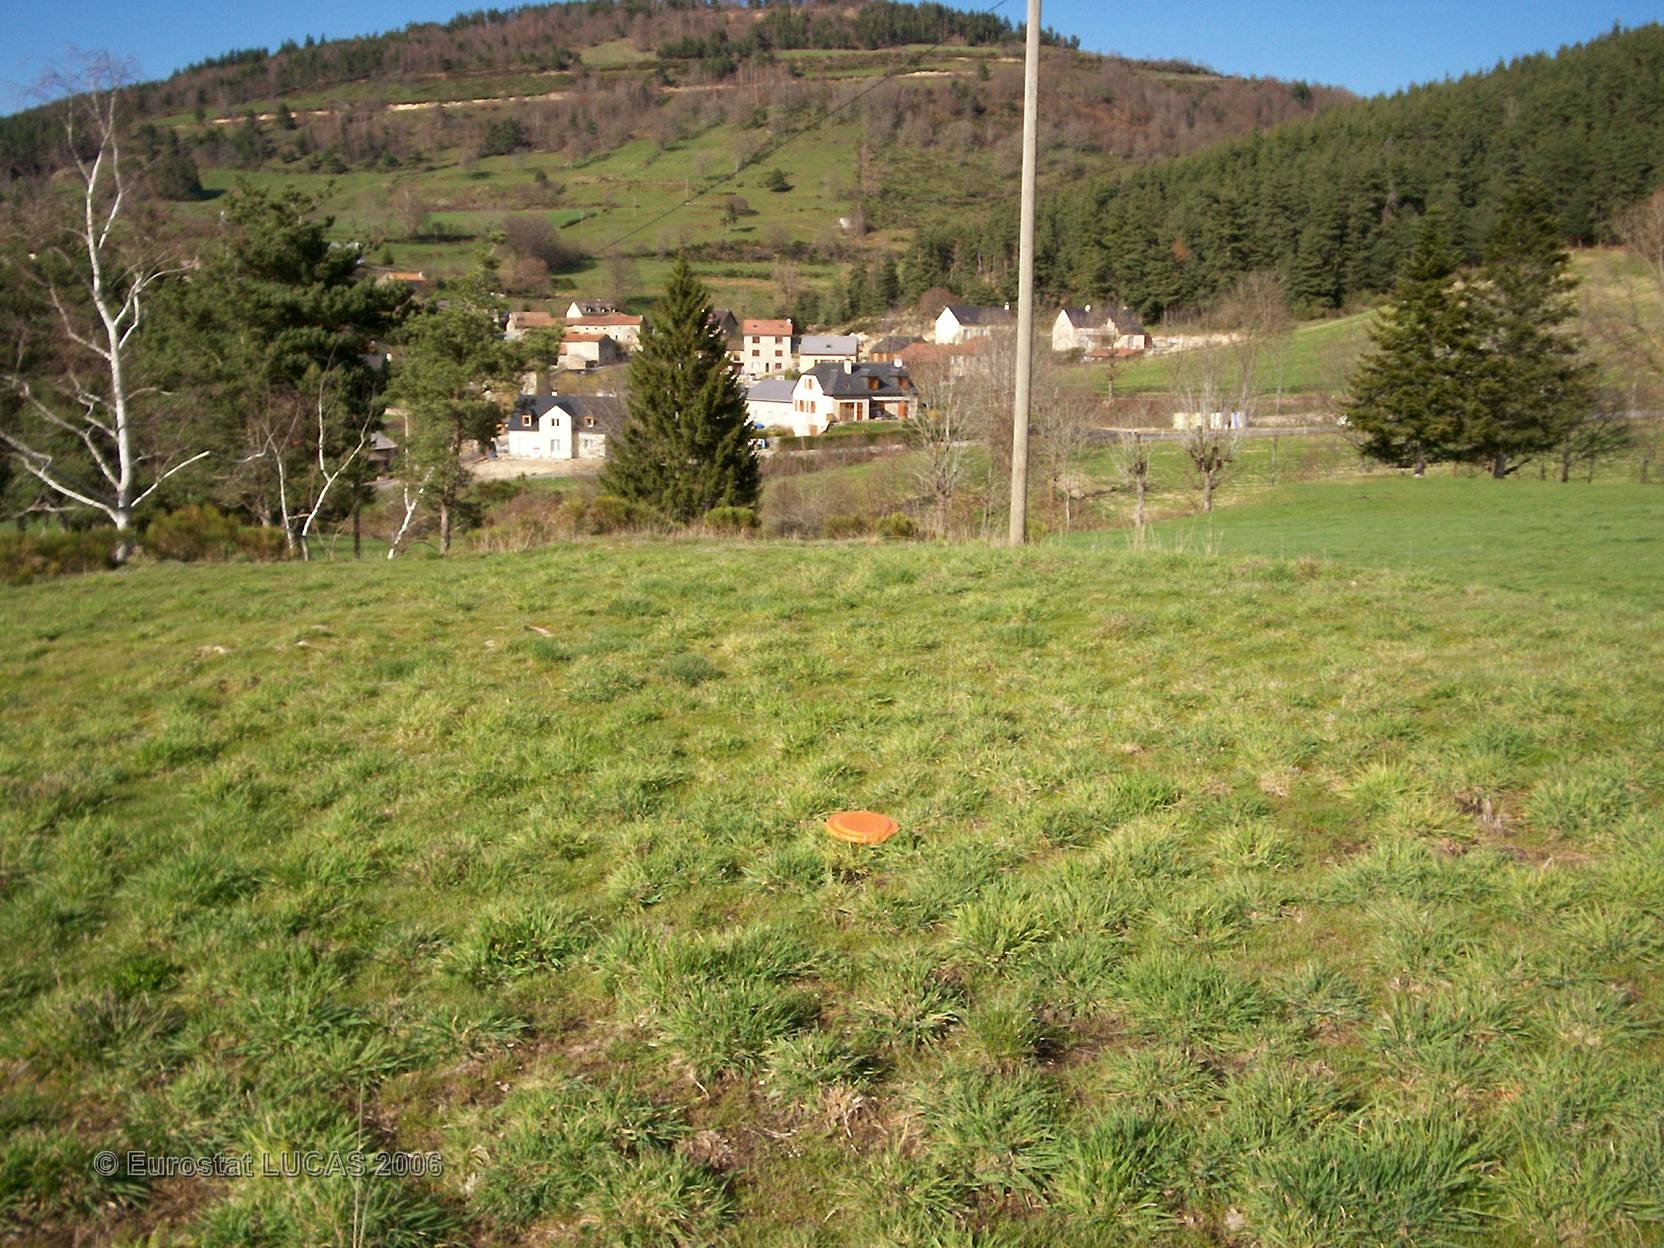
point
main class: Grassland
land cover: Grassland without tree/shrub cover
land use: Agriculture (excluding fallow land and kitchen gardens)
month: April
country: FR
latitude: 44.8434
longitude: 3.3617
